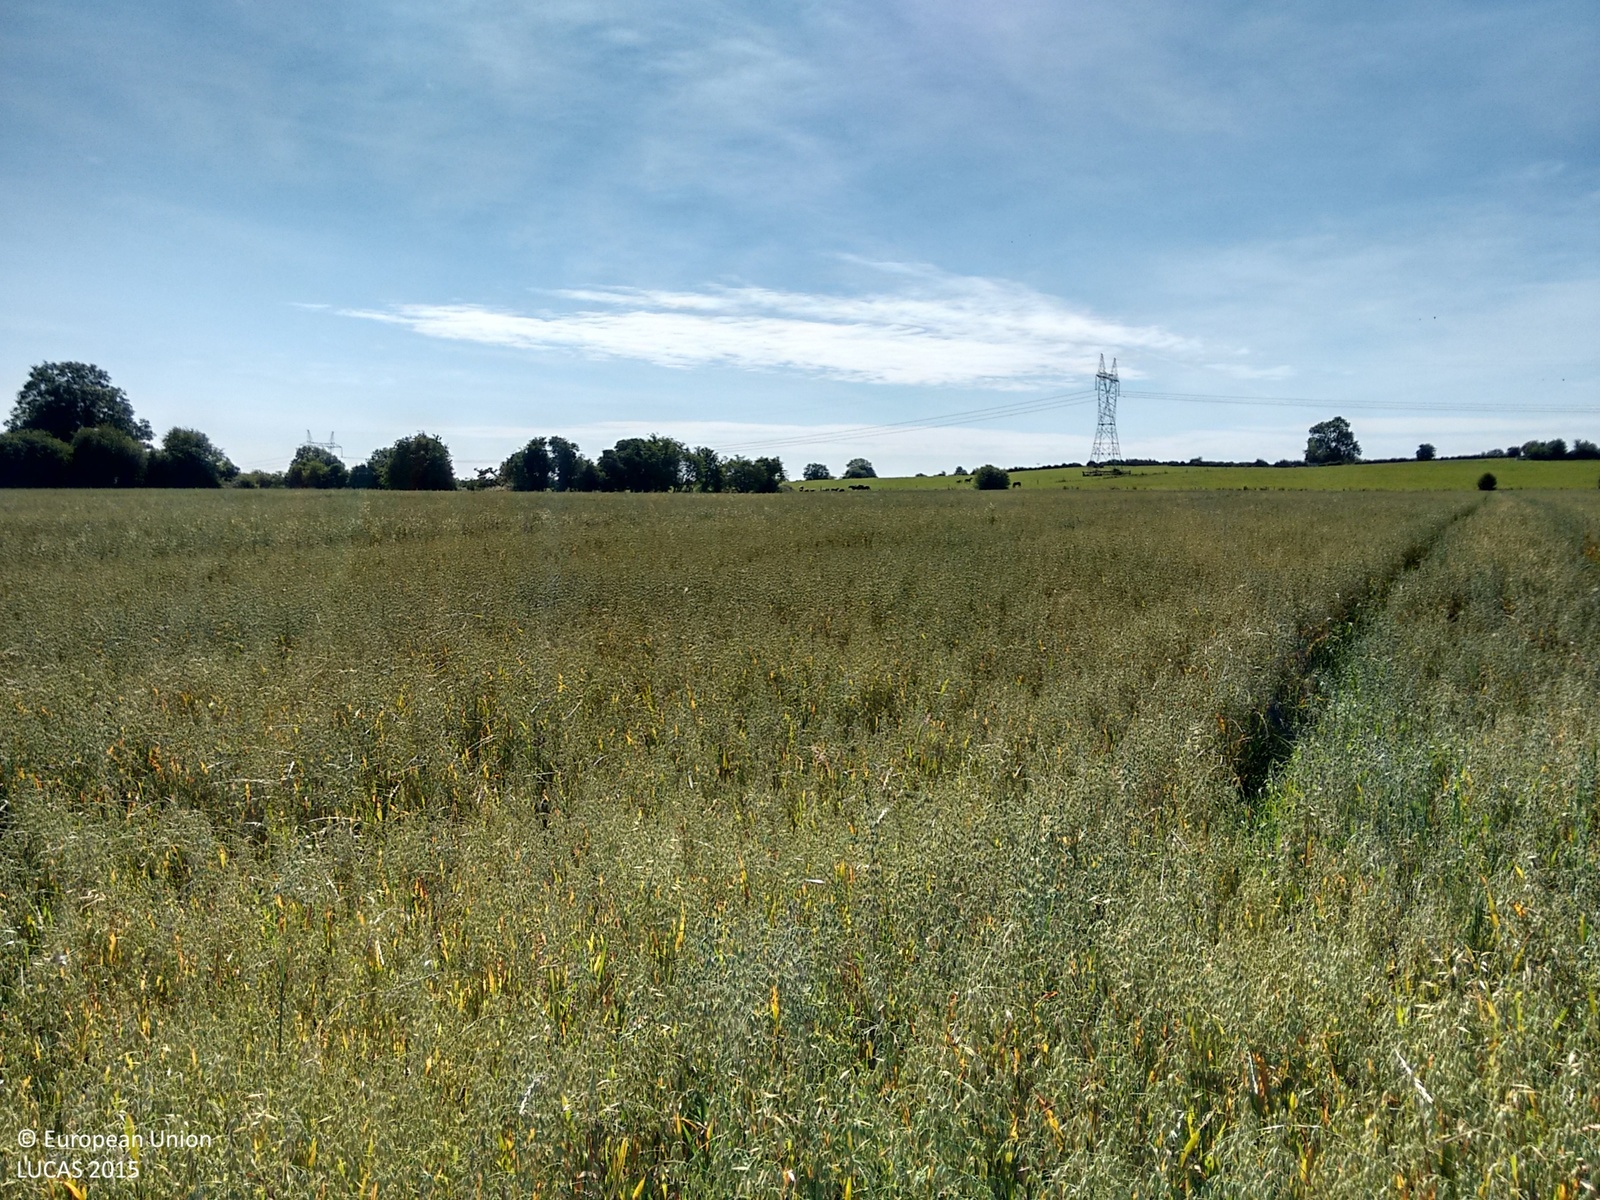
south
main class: Cropland
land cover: Oats
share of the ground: > 75 %
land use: Agriculture (excluding fallow land and kitchen gardens)
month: August
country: IE
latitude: 52.9210
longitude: -7.5165
